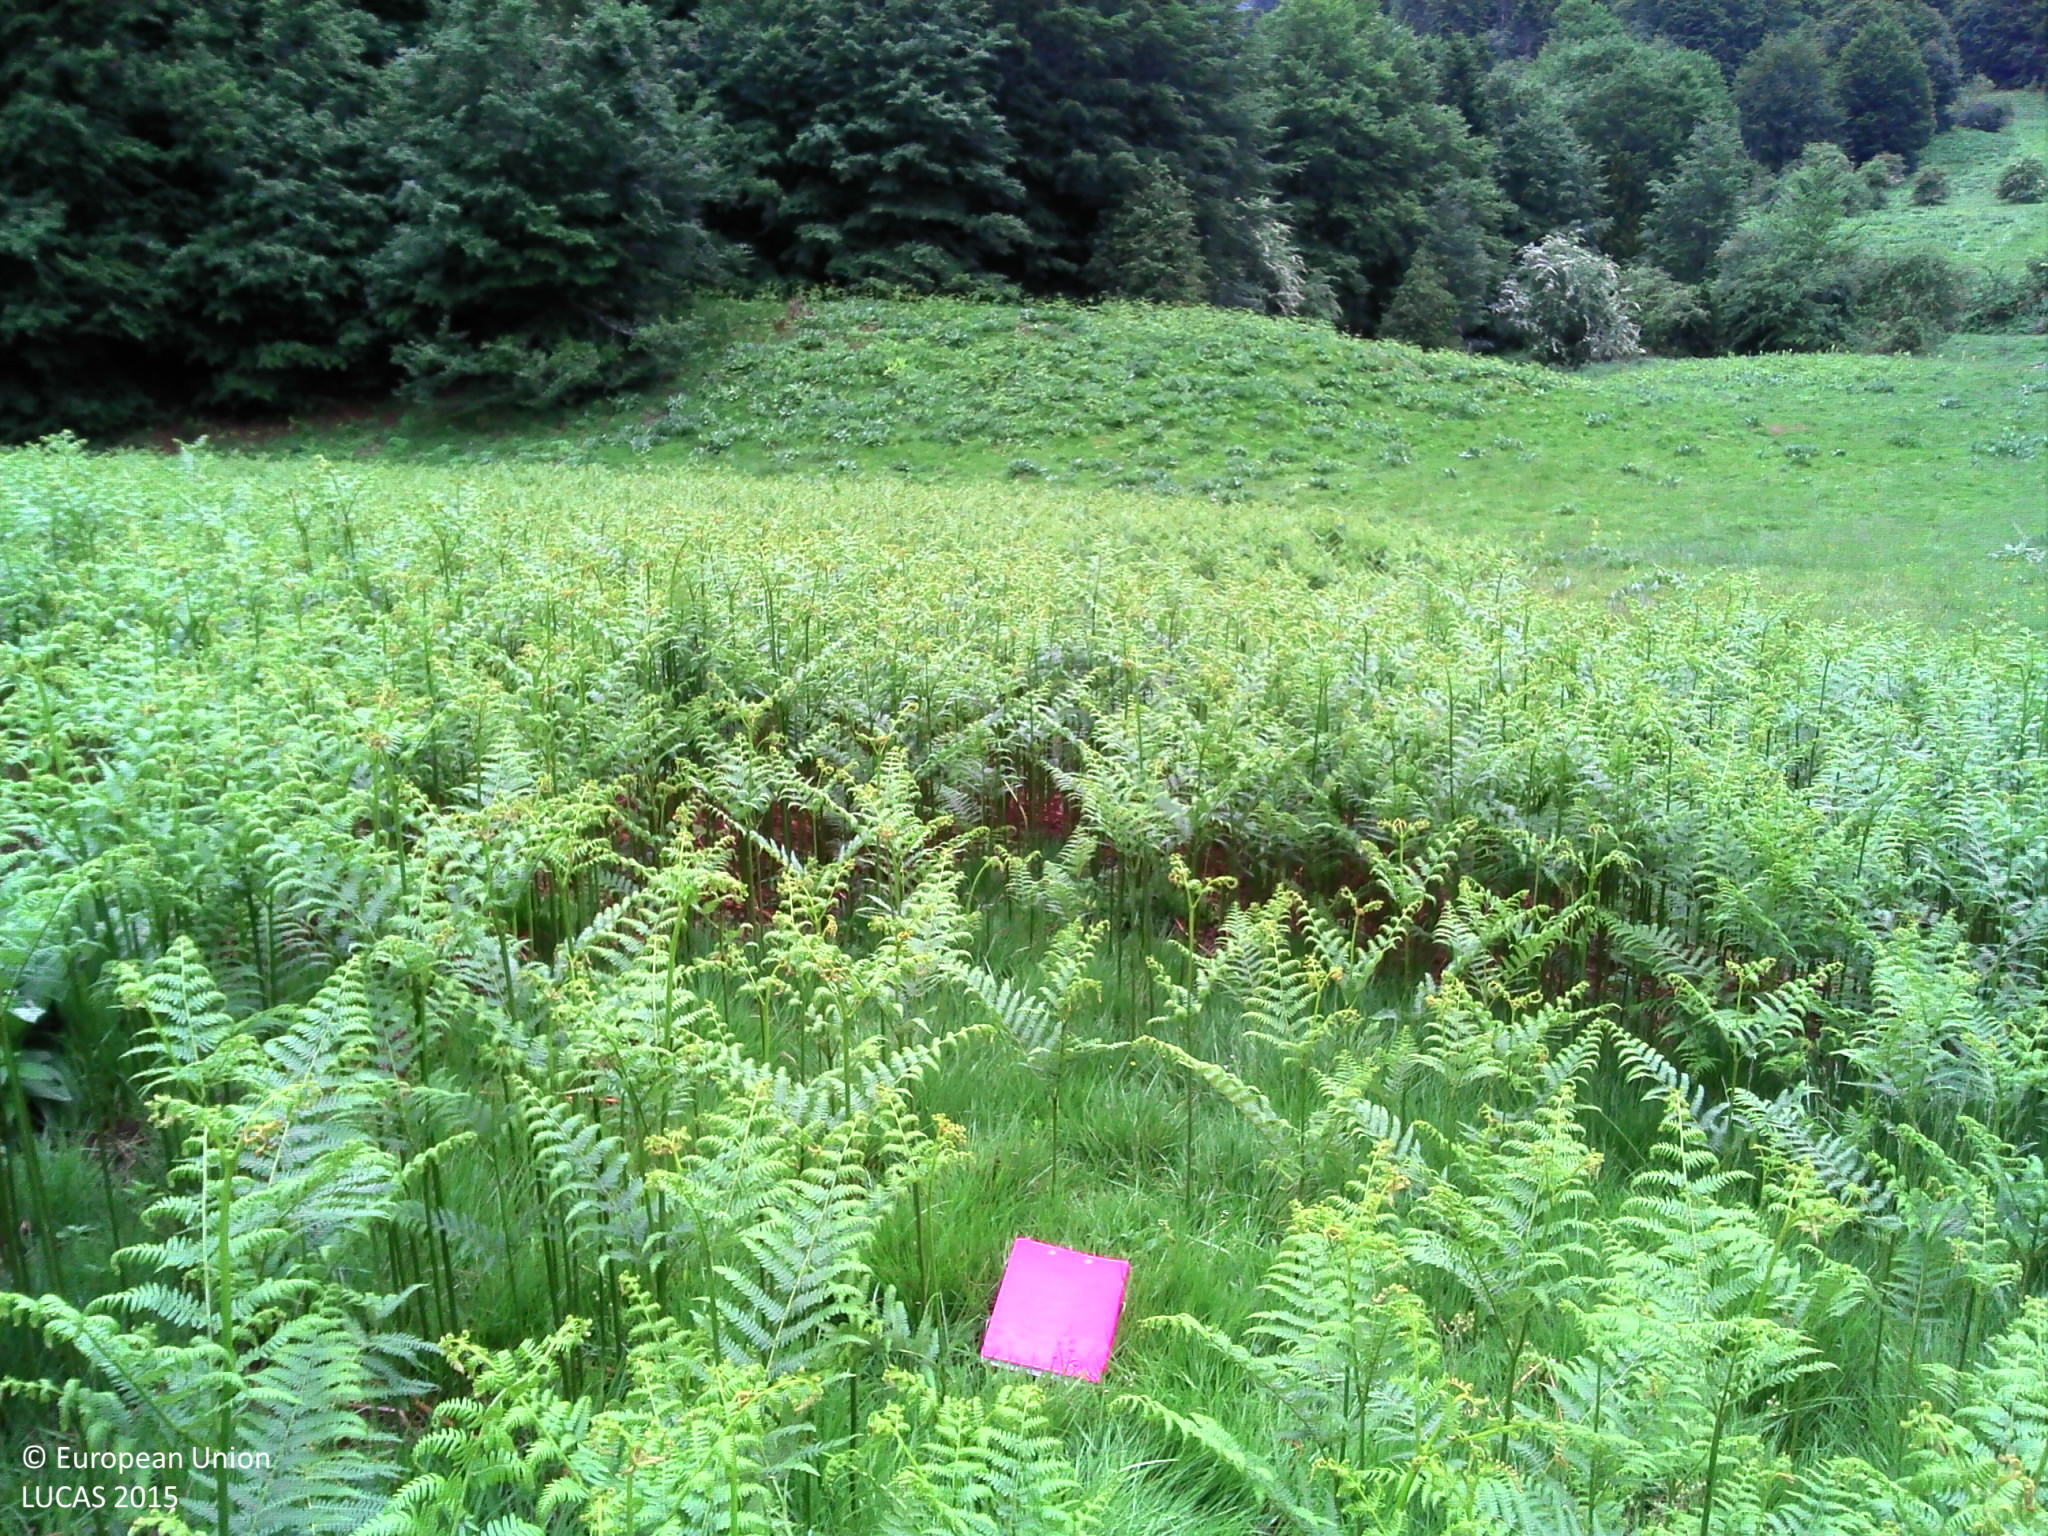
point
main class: Grassland
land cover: Grassland without tree/shrub cover
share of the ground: > 75 %
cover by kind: herbaceous plants 95 %, shrubs 5 %
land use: Agriculture (excluding fallow land and kitchen gardens)
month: June
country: FR
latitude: 42.8103
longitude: -0.5585
